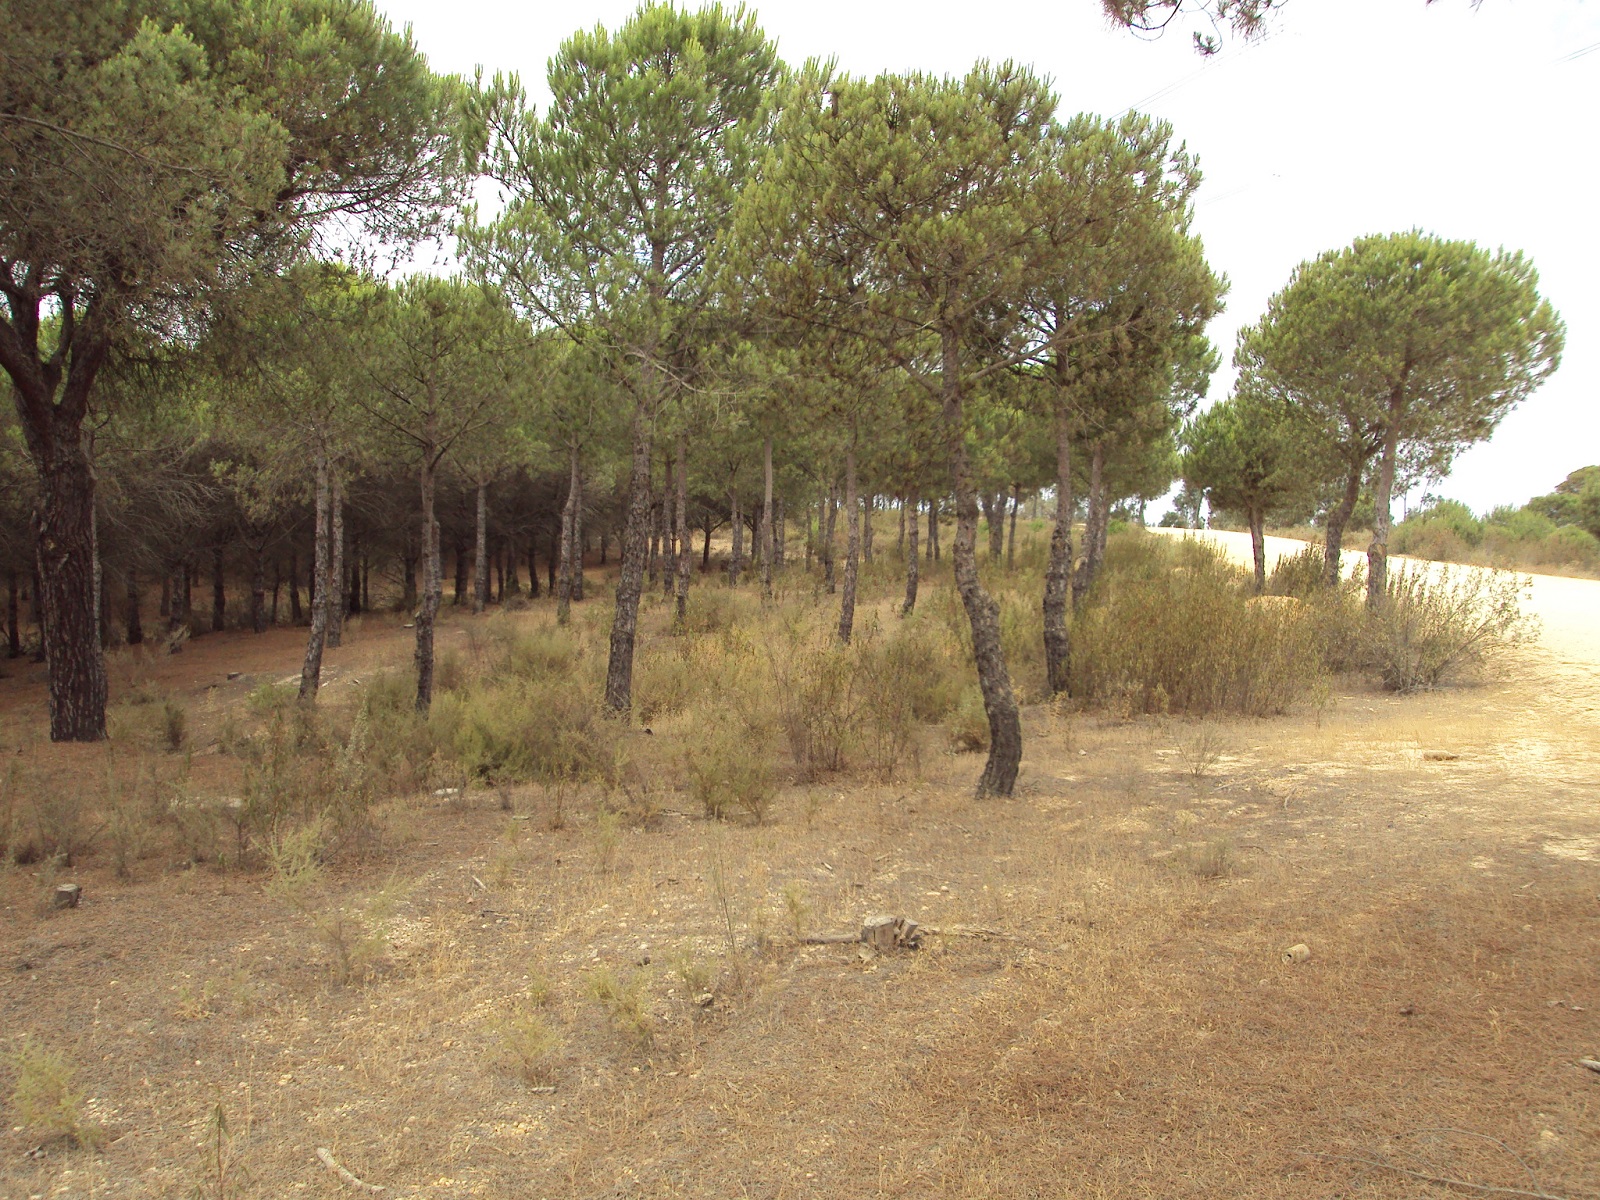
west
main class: Woodland
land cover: Pine dominated coniferous woodland
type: coniferous forest of the mediterranean region
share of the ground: 50 - 75 %
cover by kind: coniferous forest trees 60 %, herbaceous plants 30 %, shrubs 10 %
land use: Forestry
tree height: > 5 m
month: June
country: ES
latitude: 37.2273
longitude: -6.8630
